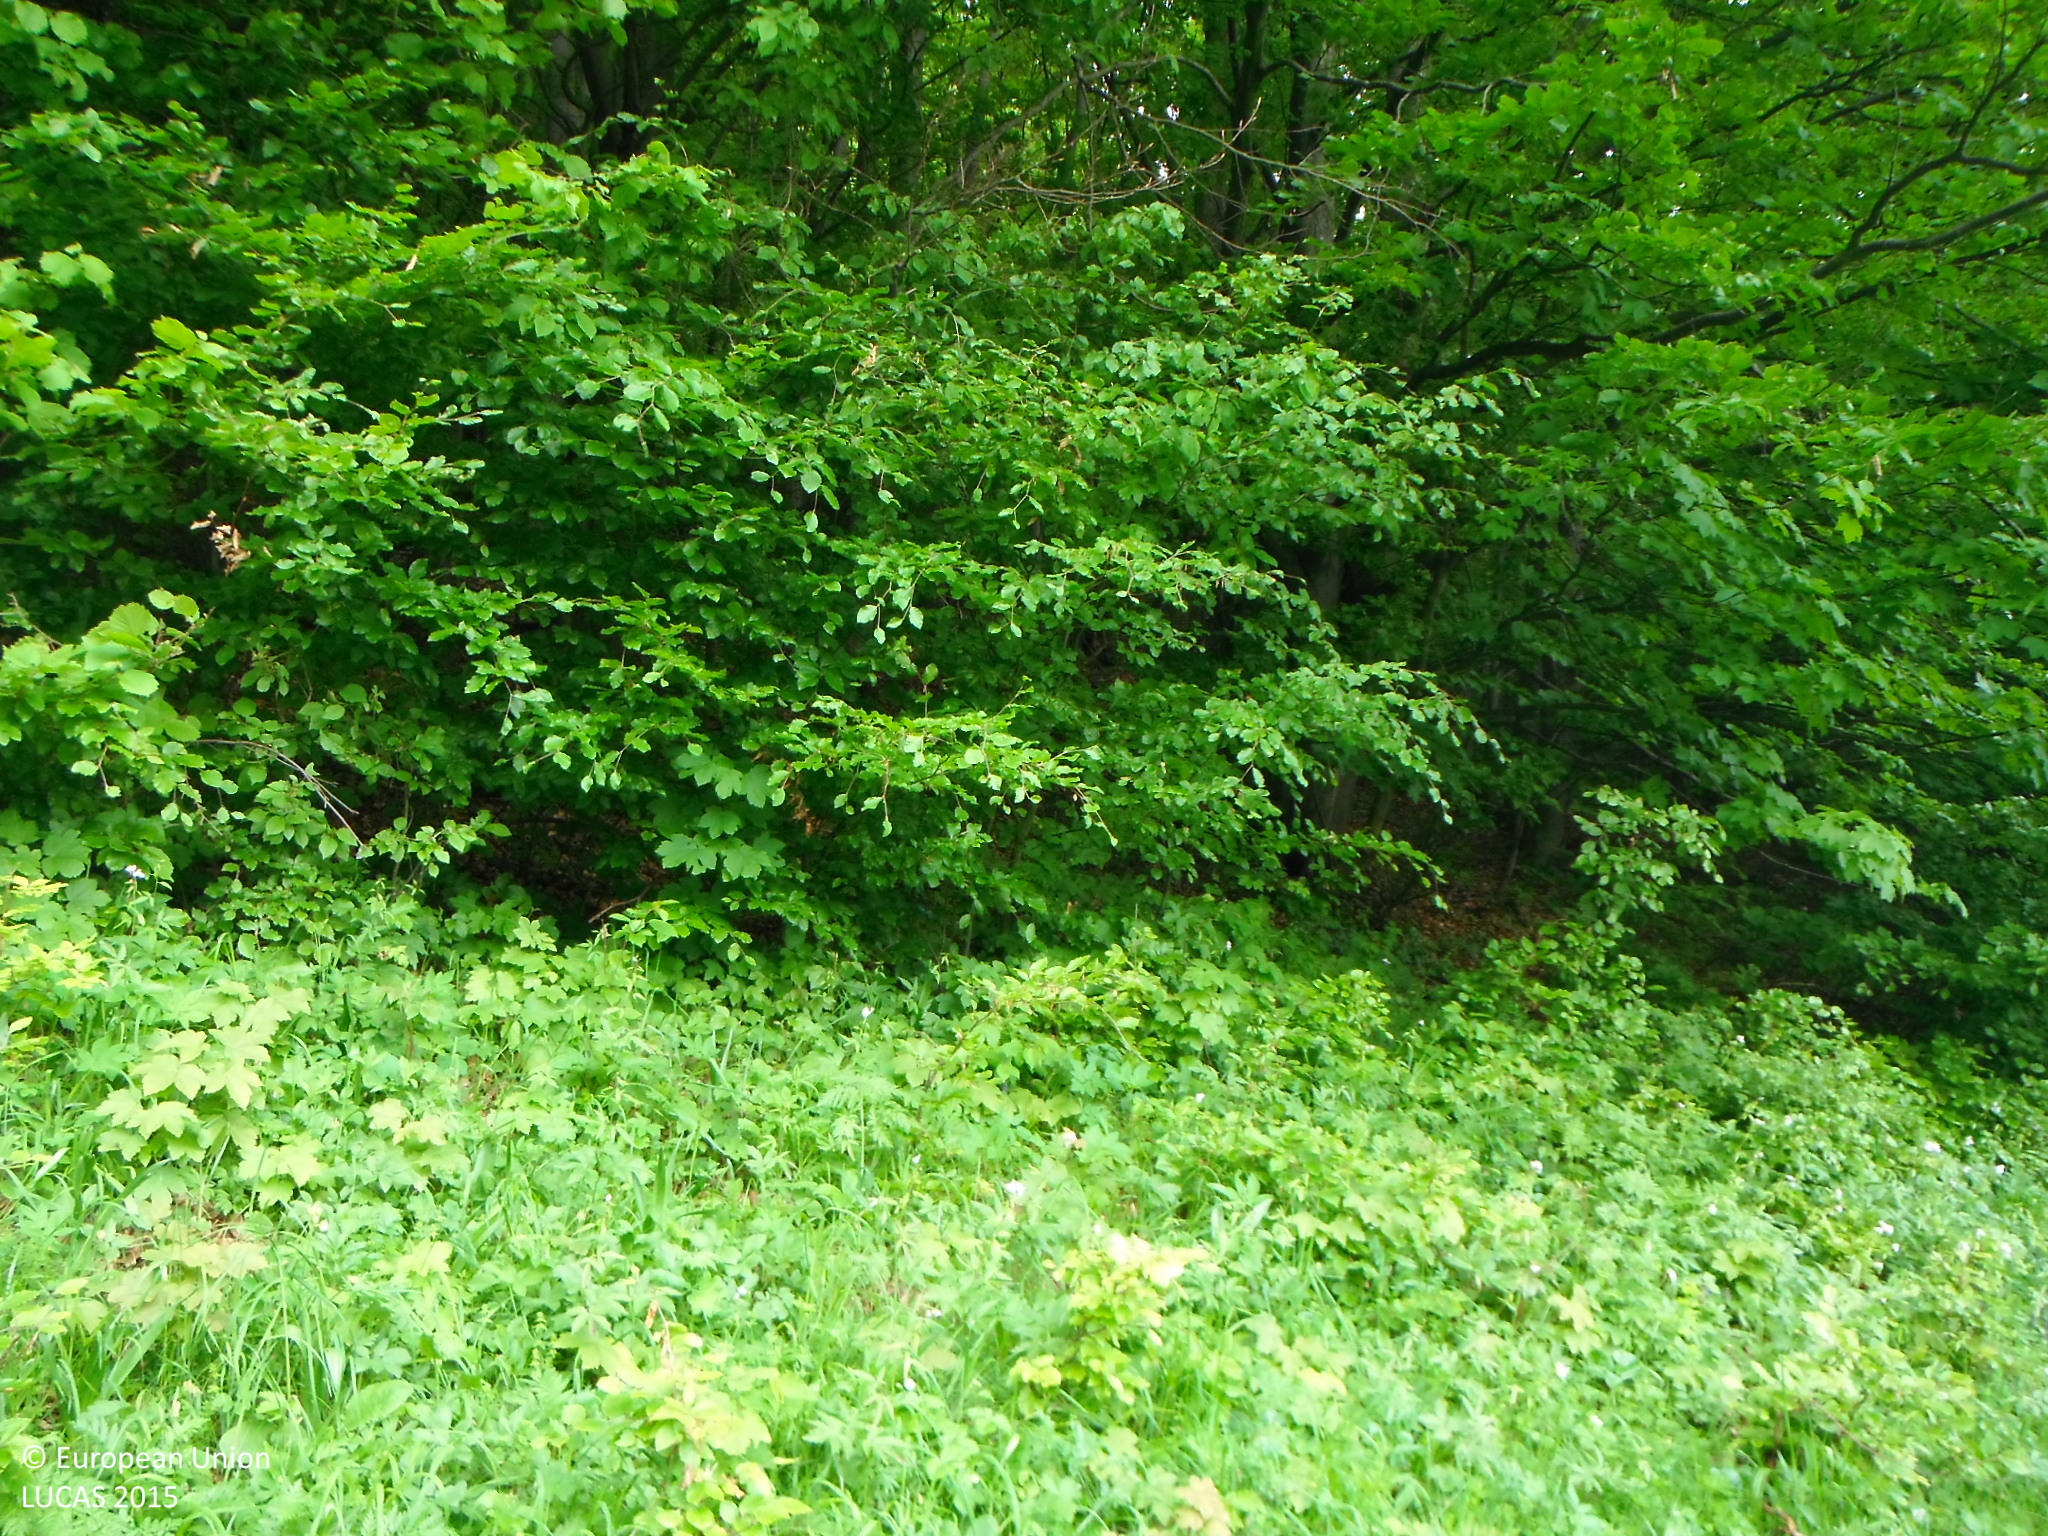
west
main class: Grassland
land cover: Grassland without tree/shrub cover
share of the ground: > 75 %
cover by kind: herbaceous plants 100 %
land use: Agriculture (excluding fallow land and kitchen gardens)
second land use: Sport
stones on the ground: < 10 %
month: May
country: SK
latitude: 48.8013
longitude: 19.1580
